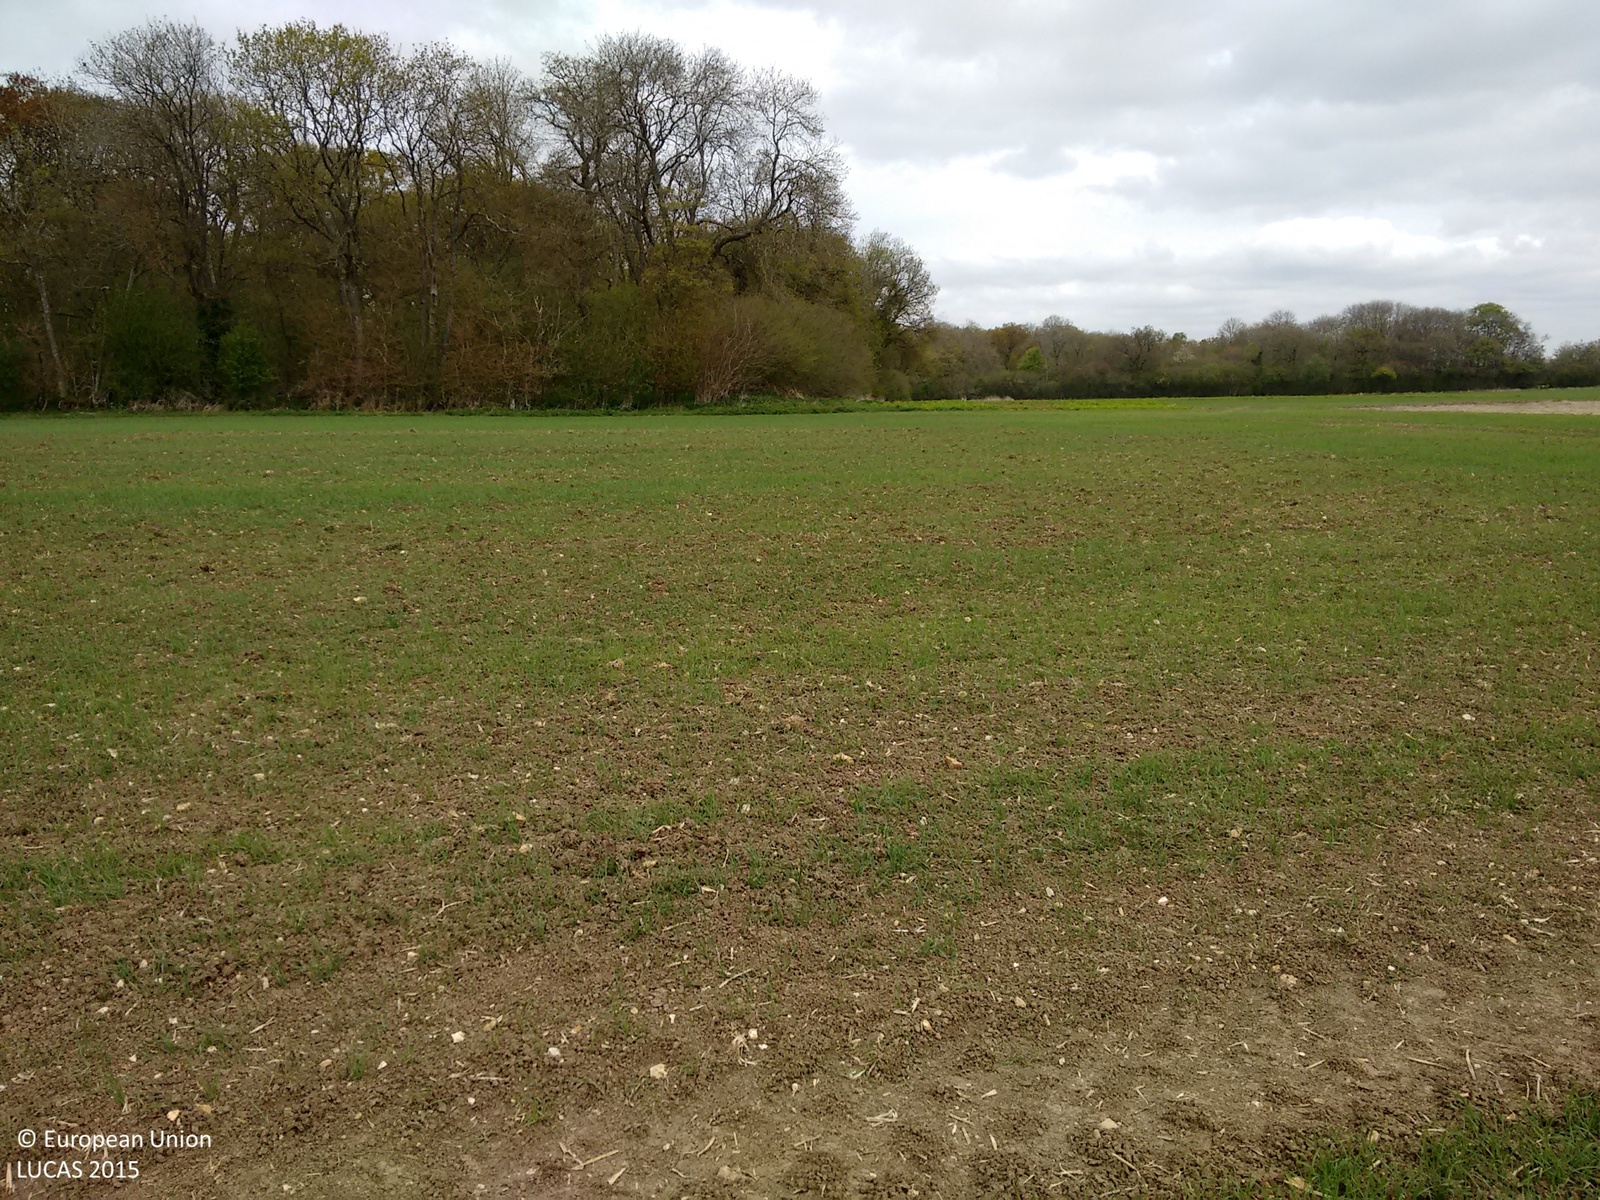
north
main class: Cropland
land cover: Common wheat
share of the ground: 50 - 75 %
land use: Agriculture (excluding fallow land and kitchen gardens)
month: May
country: GB
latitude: 51.1229
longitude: -0.9741
